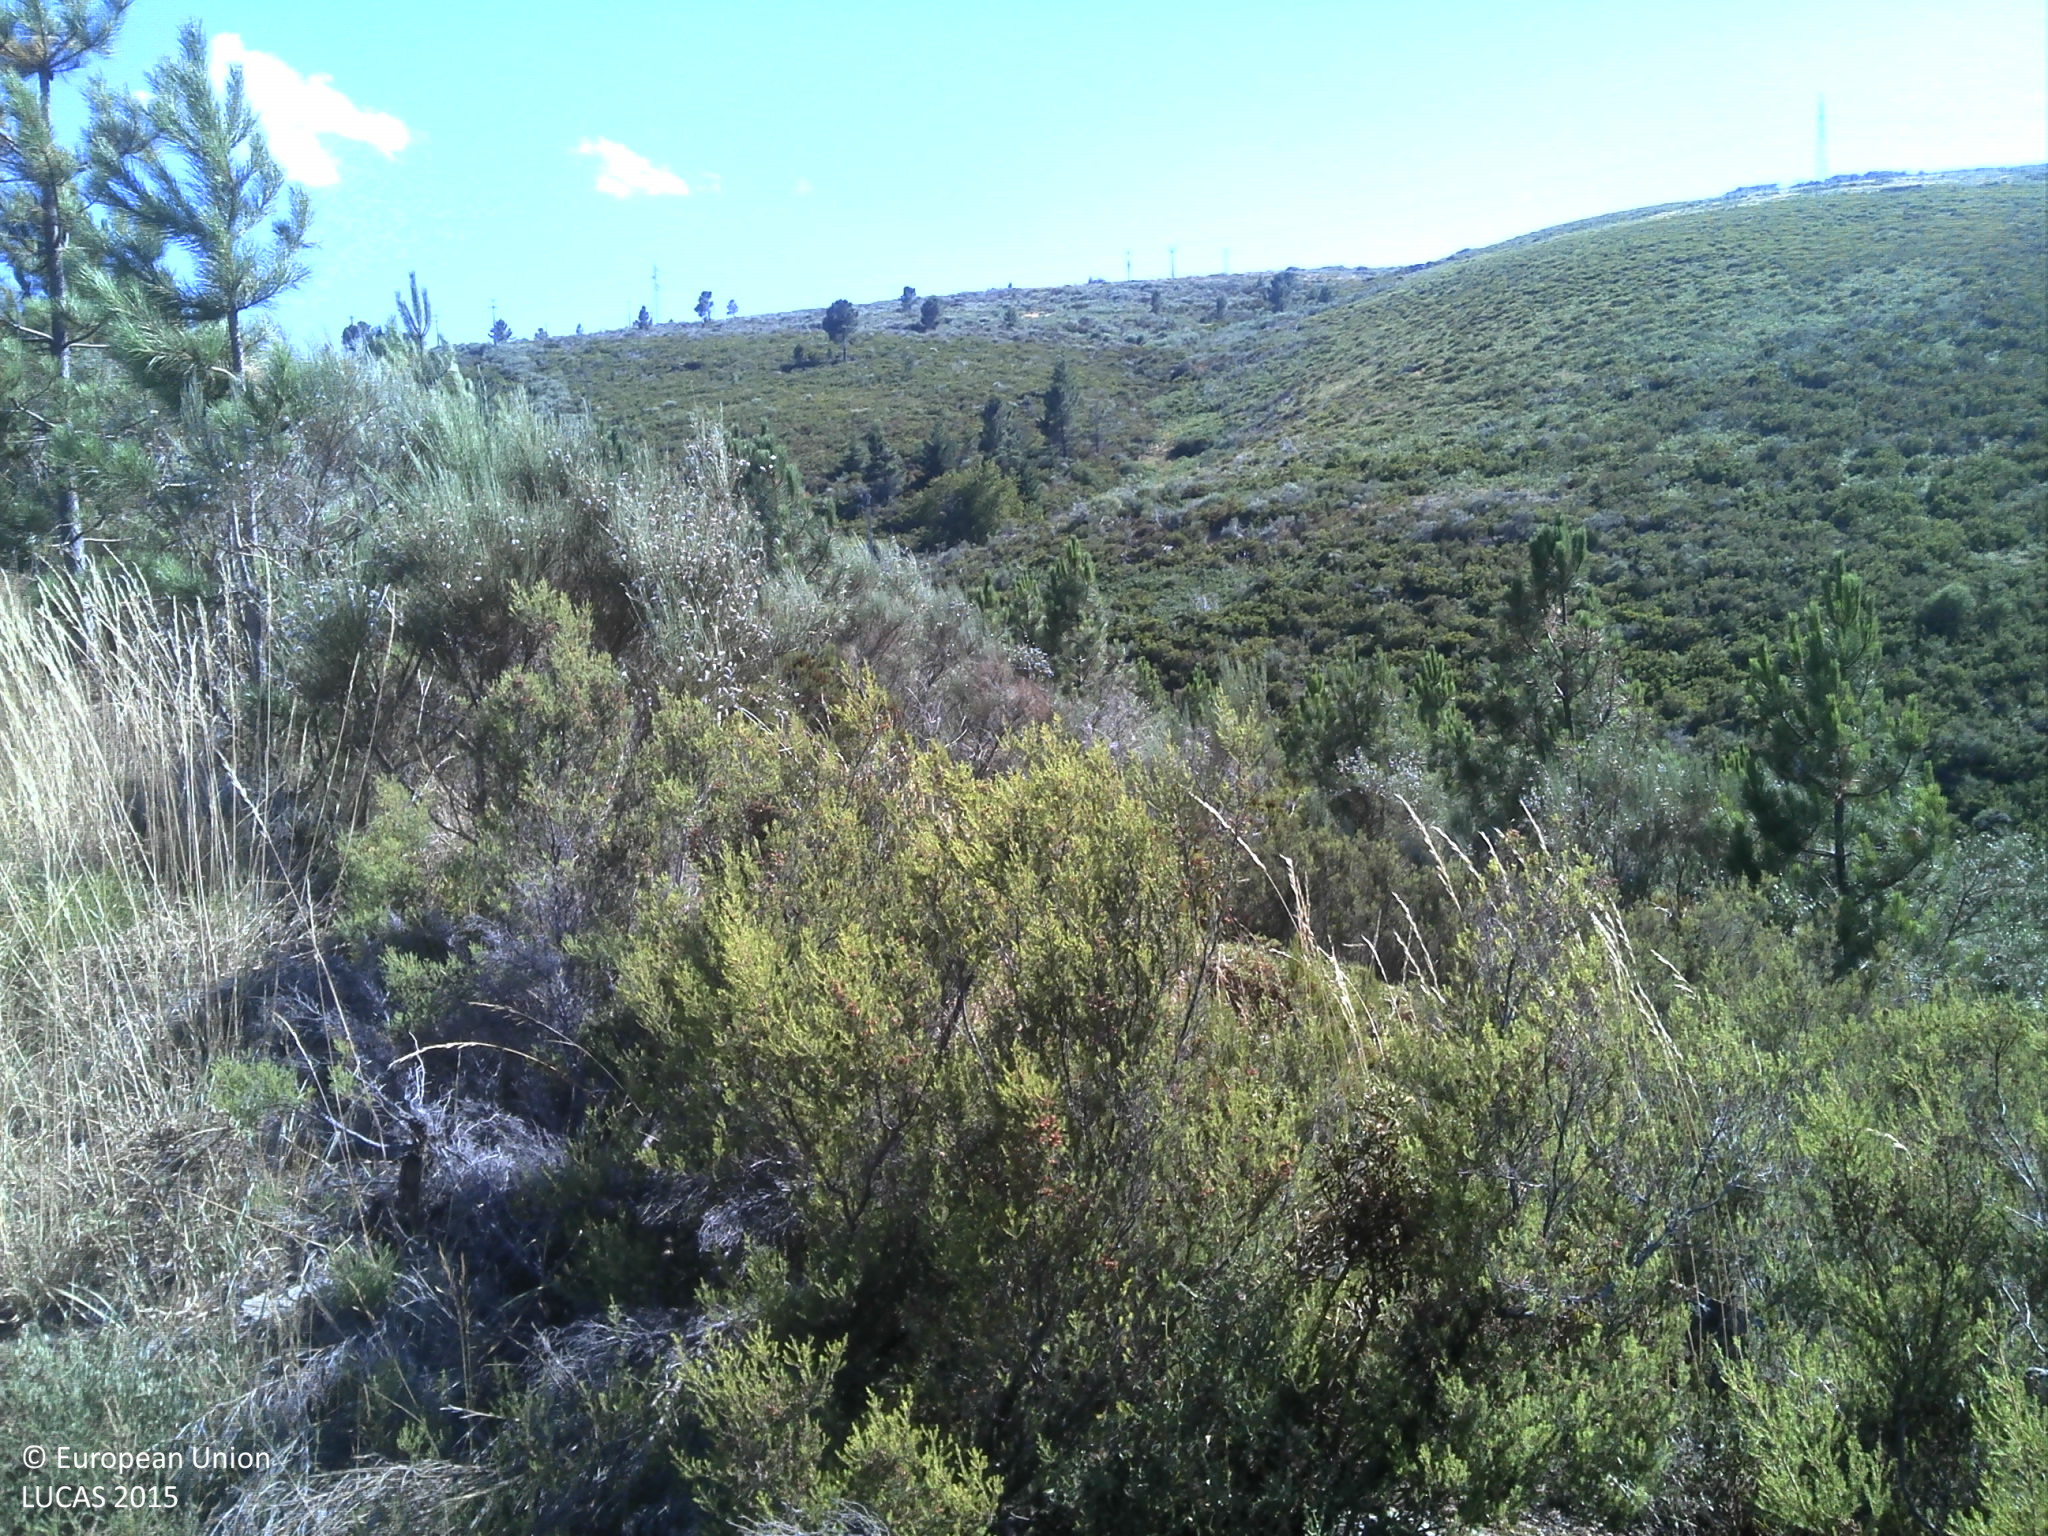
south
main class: Shrubland
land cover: Shrubland with sparse tree cover
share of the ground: 50 - 75 %
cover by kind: shrubs 75 %, unconsolidated bare surface 15 %, coniferous forest trees 5 %
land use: Semi-natural and natural areas not in use
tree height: > 5 m
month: July
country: PT
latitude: 40.4261
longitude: -7.5436
